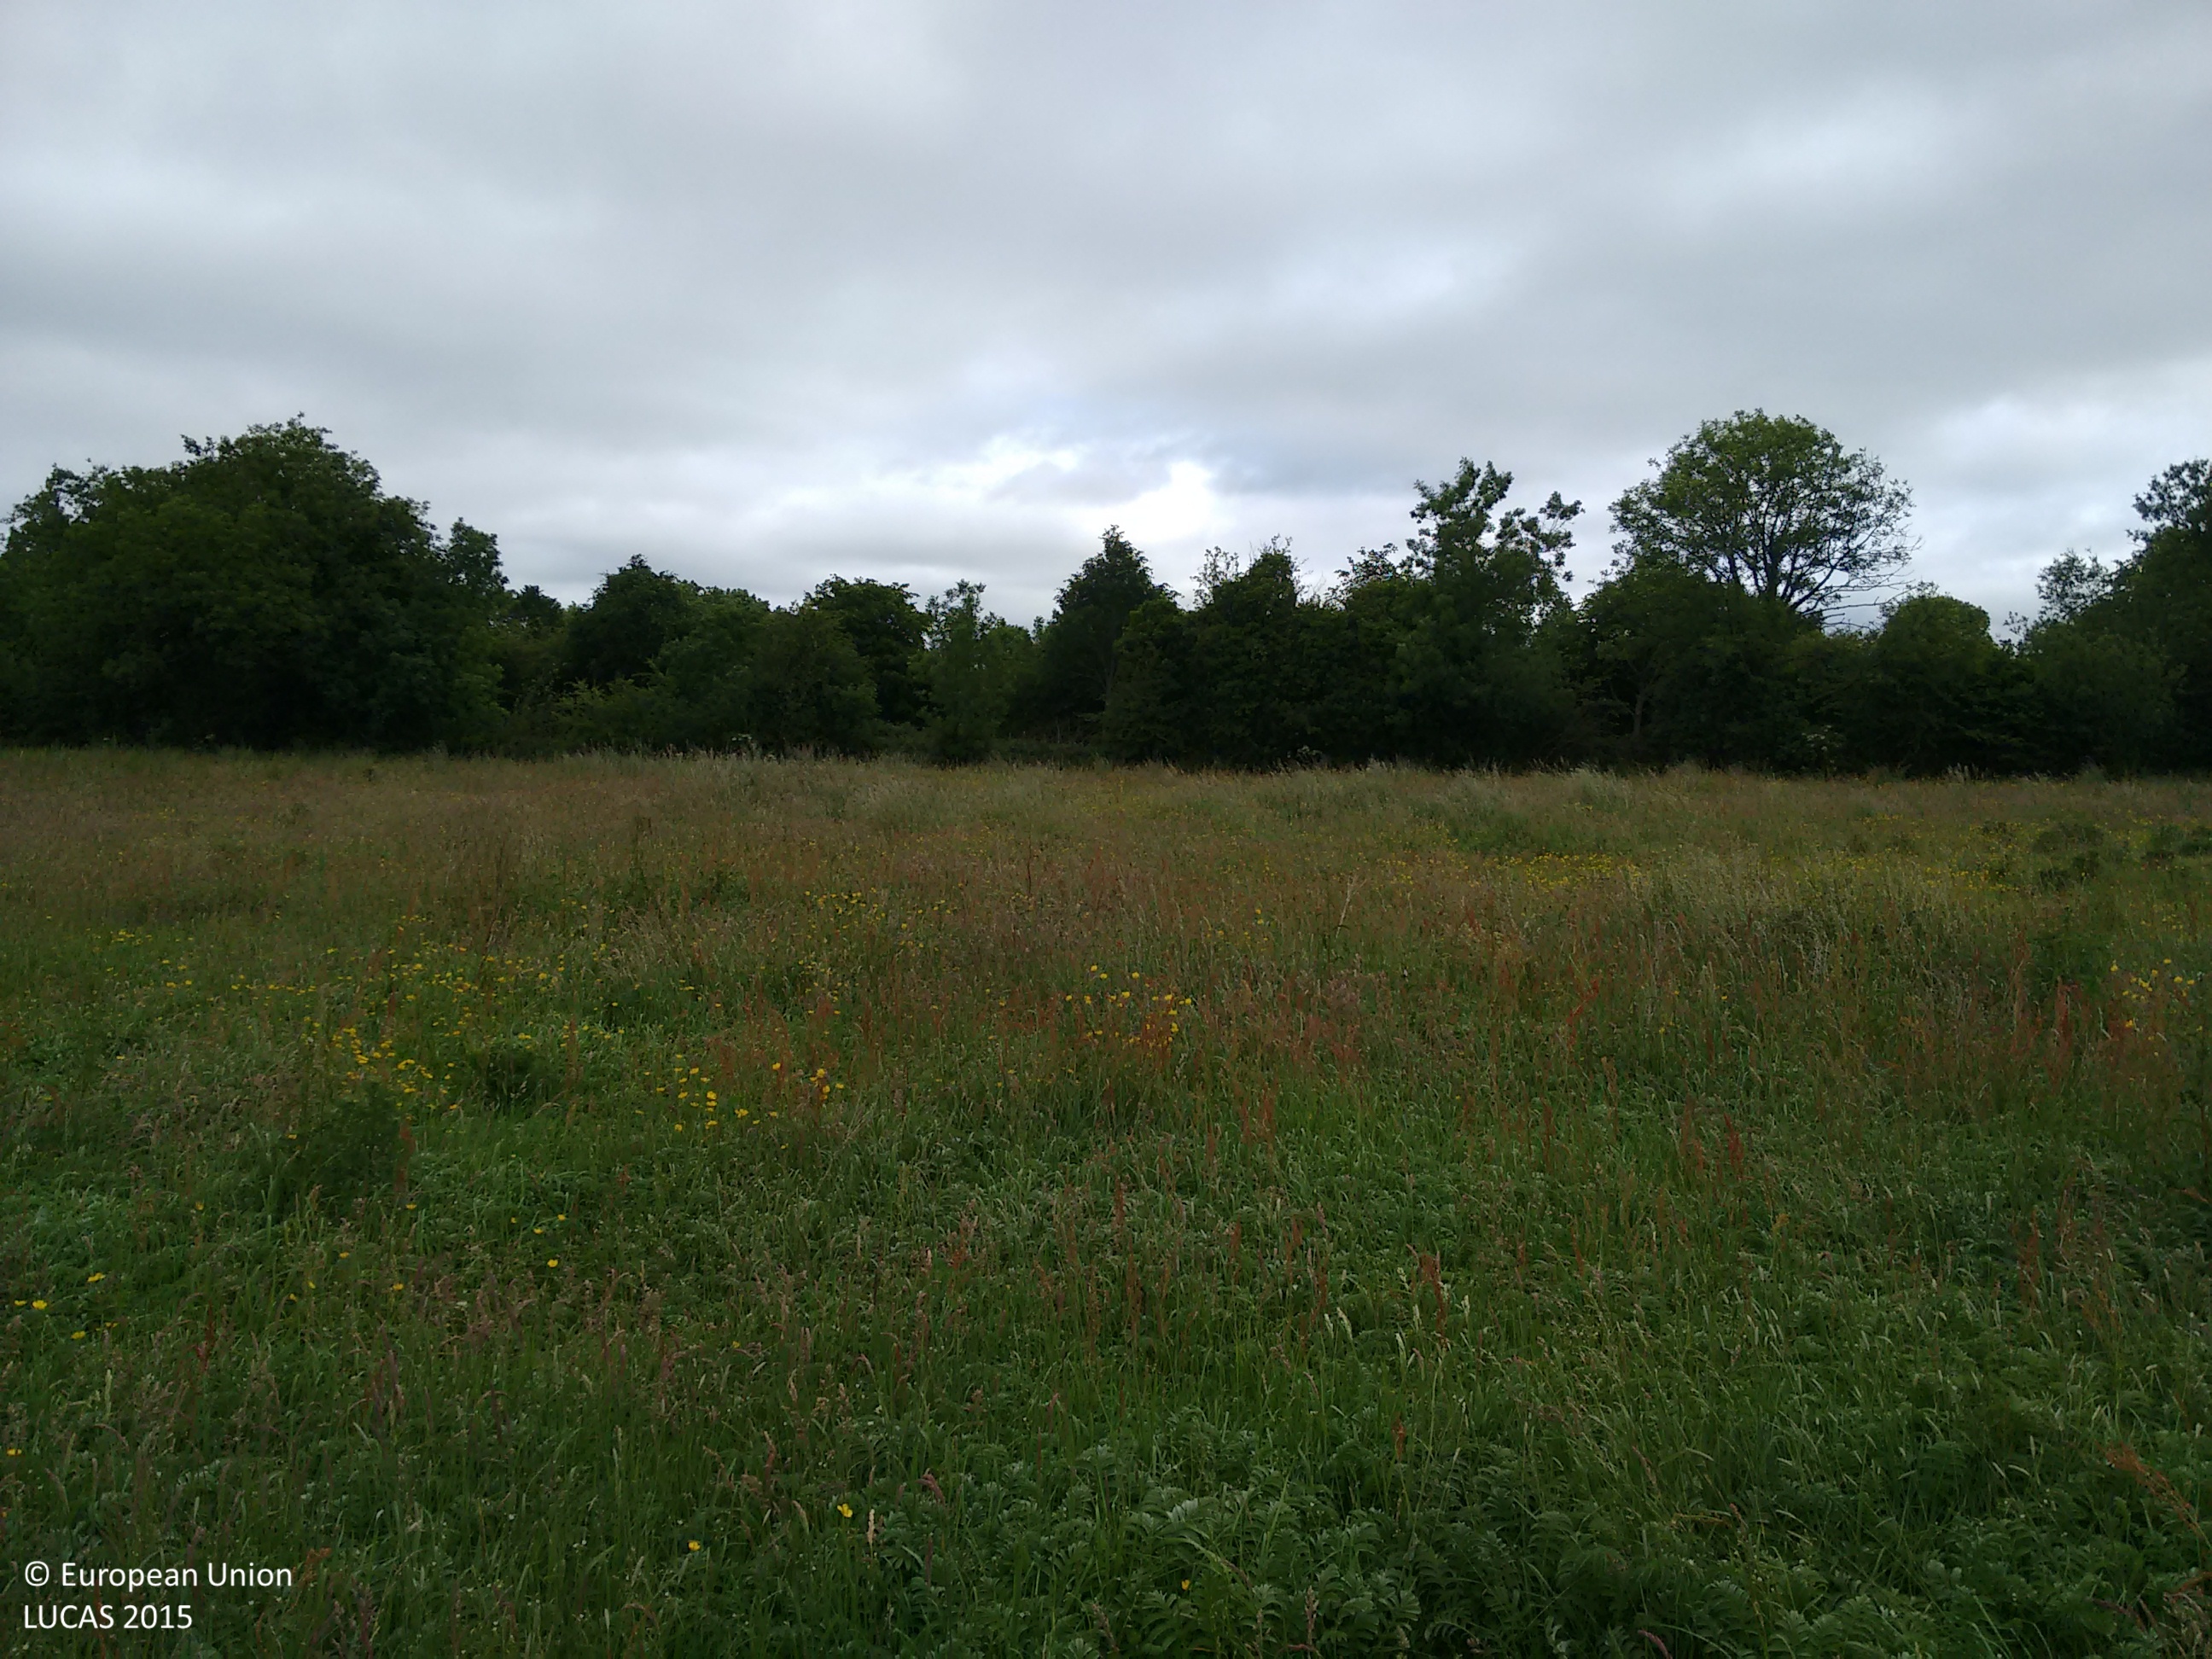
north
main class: Grassland
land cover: Spontaneously vegetated surfaces
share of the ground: > 75 %
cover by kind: herbaceous plants 95 %, shrubs 5 %
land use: Abandoned areas
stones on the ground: < 10 %
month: June
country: IE
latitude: 53.3897
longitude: -7.7128
